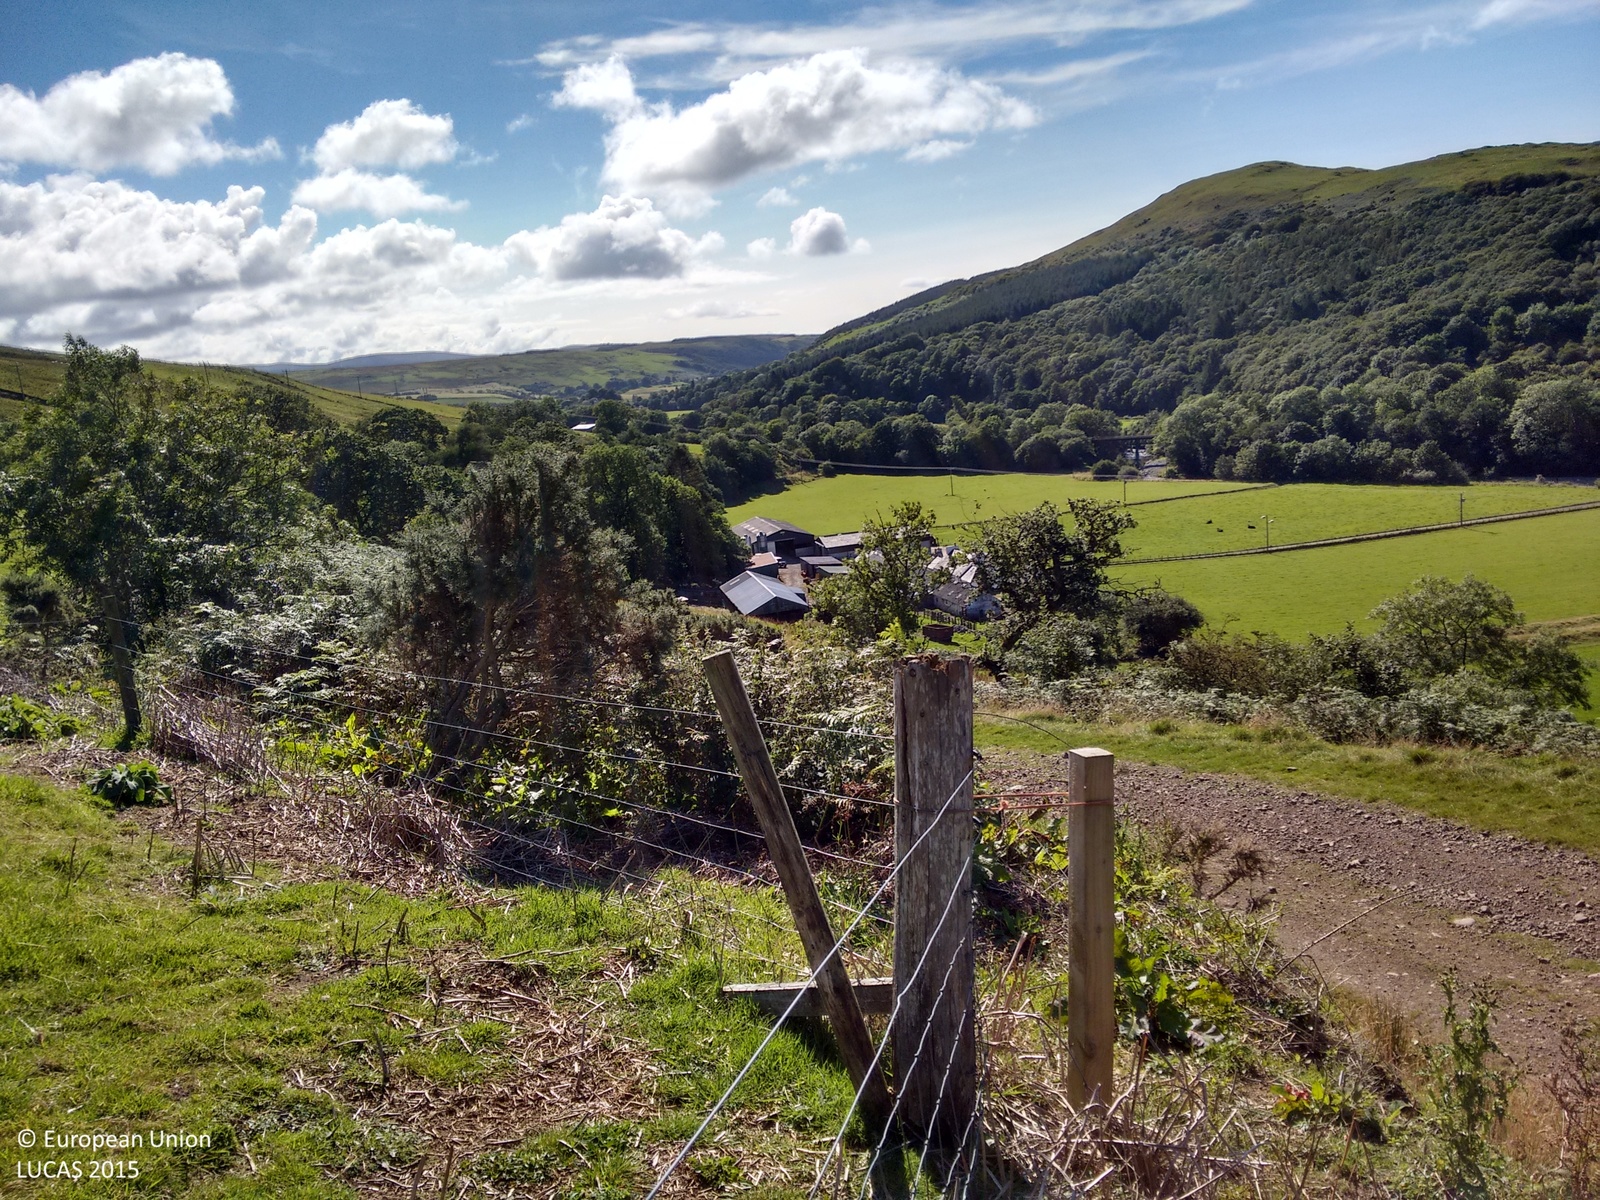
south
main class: Grassland
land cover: Grassland without tree/shrub cover
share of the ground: > 75 %
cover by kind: herbaceous plants 100 %
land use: Agriculture (excluding fallow land and kitchen gardens)
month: September
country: GB
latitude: 55.1562
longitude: -4.8139
